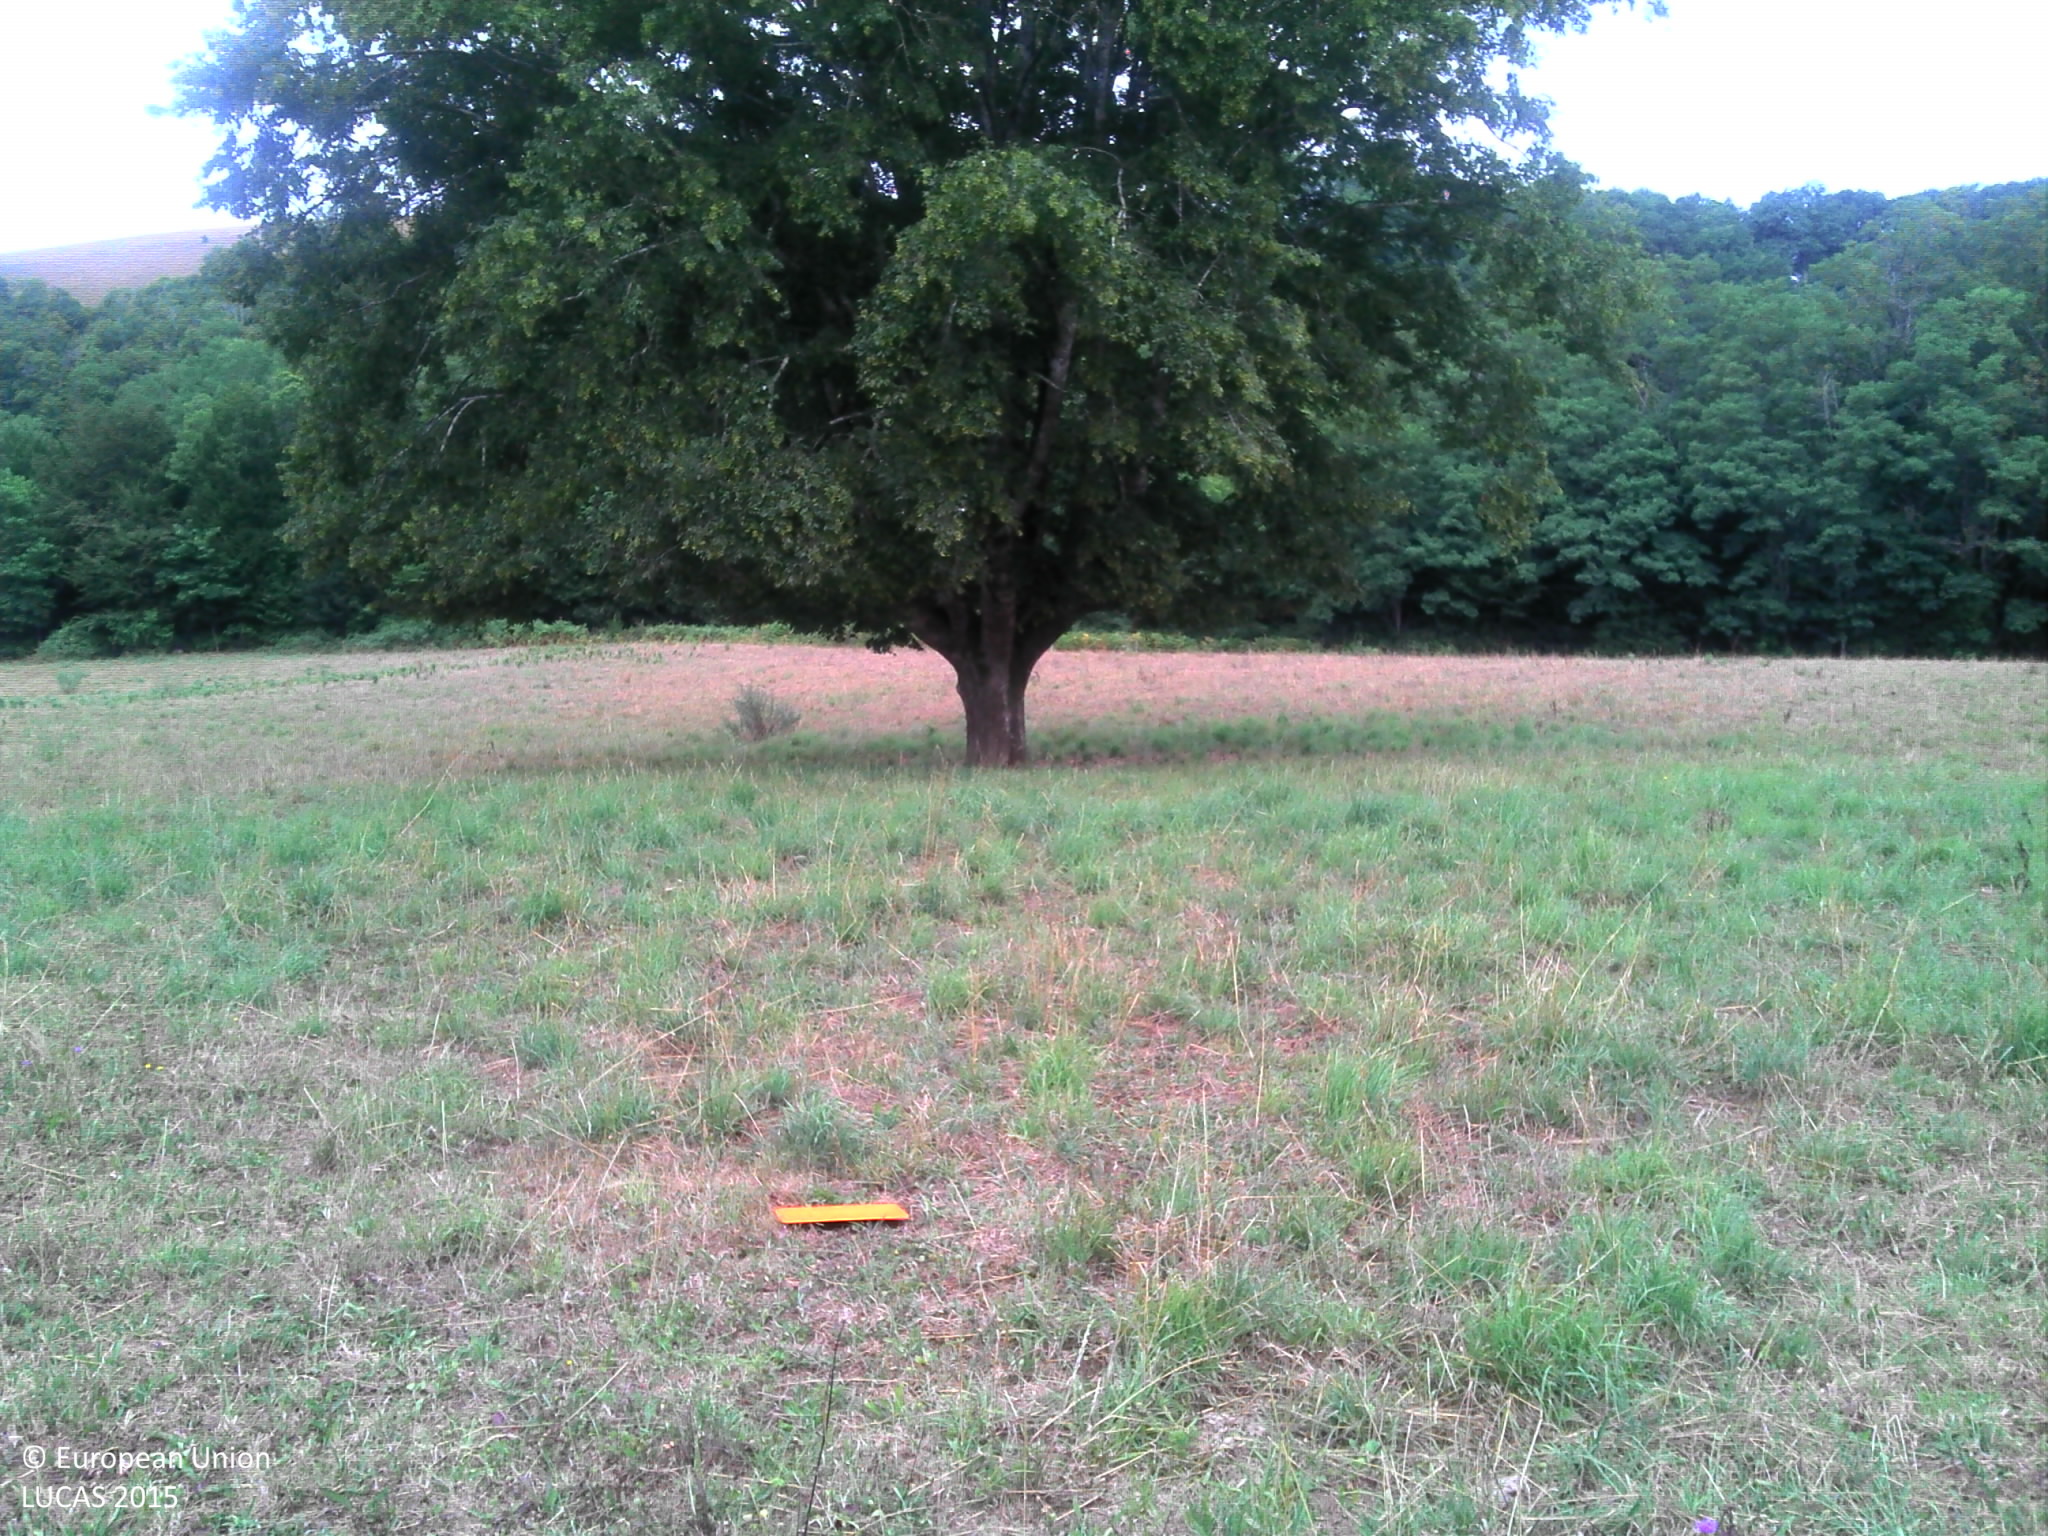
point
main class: Grassland
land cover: Grassland without tree/shrub cover
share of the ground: > 75 %
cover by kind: herbaceous plants 95 %, shrubs 5 %
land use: Agriculture (excluding fallow land and kitchen gardens)
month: July
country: FR
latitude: 45.3608
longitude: 1.5047
